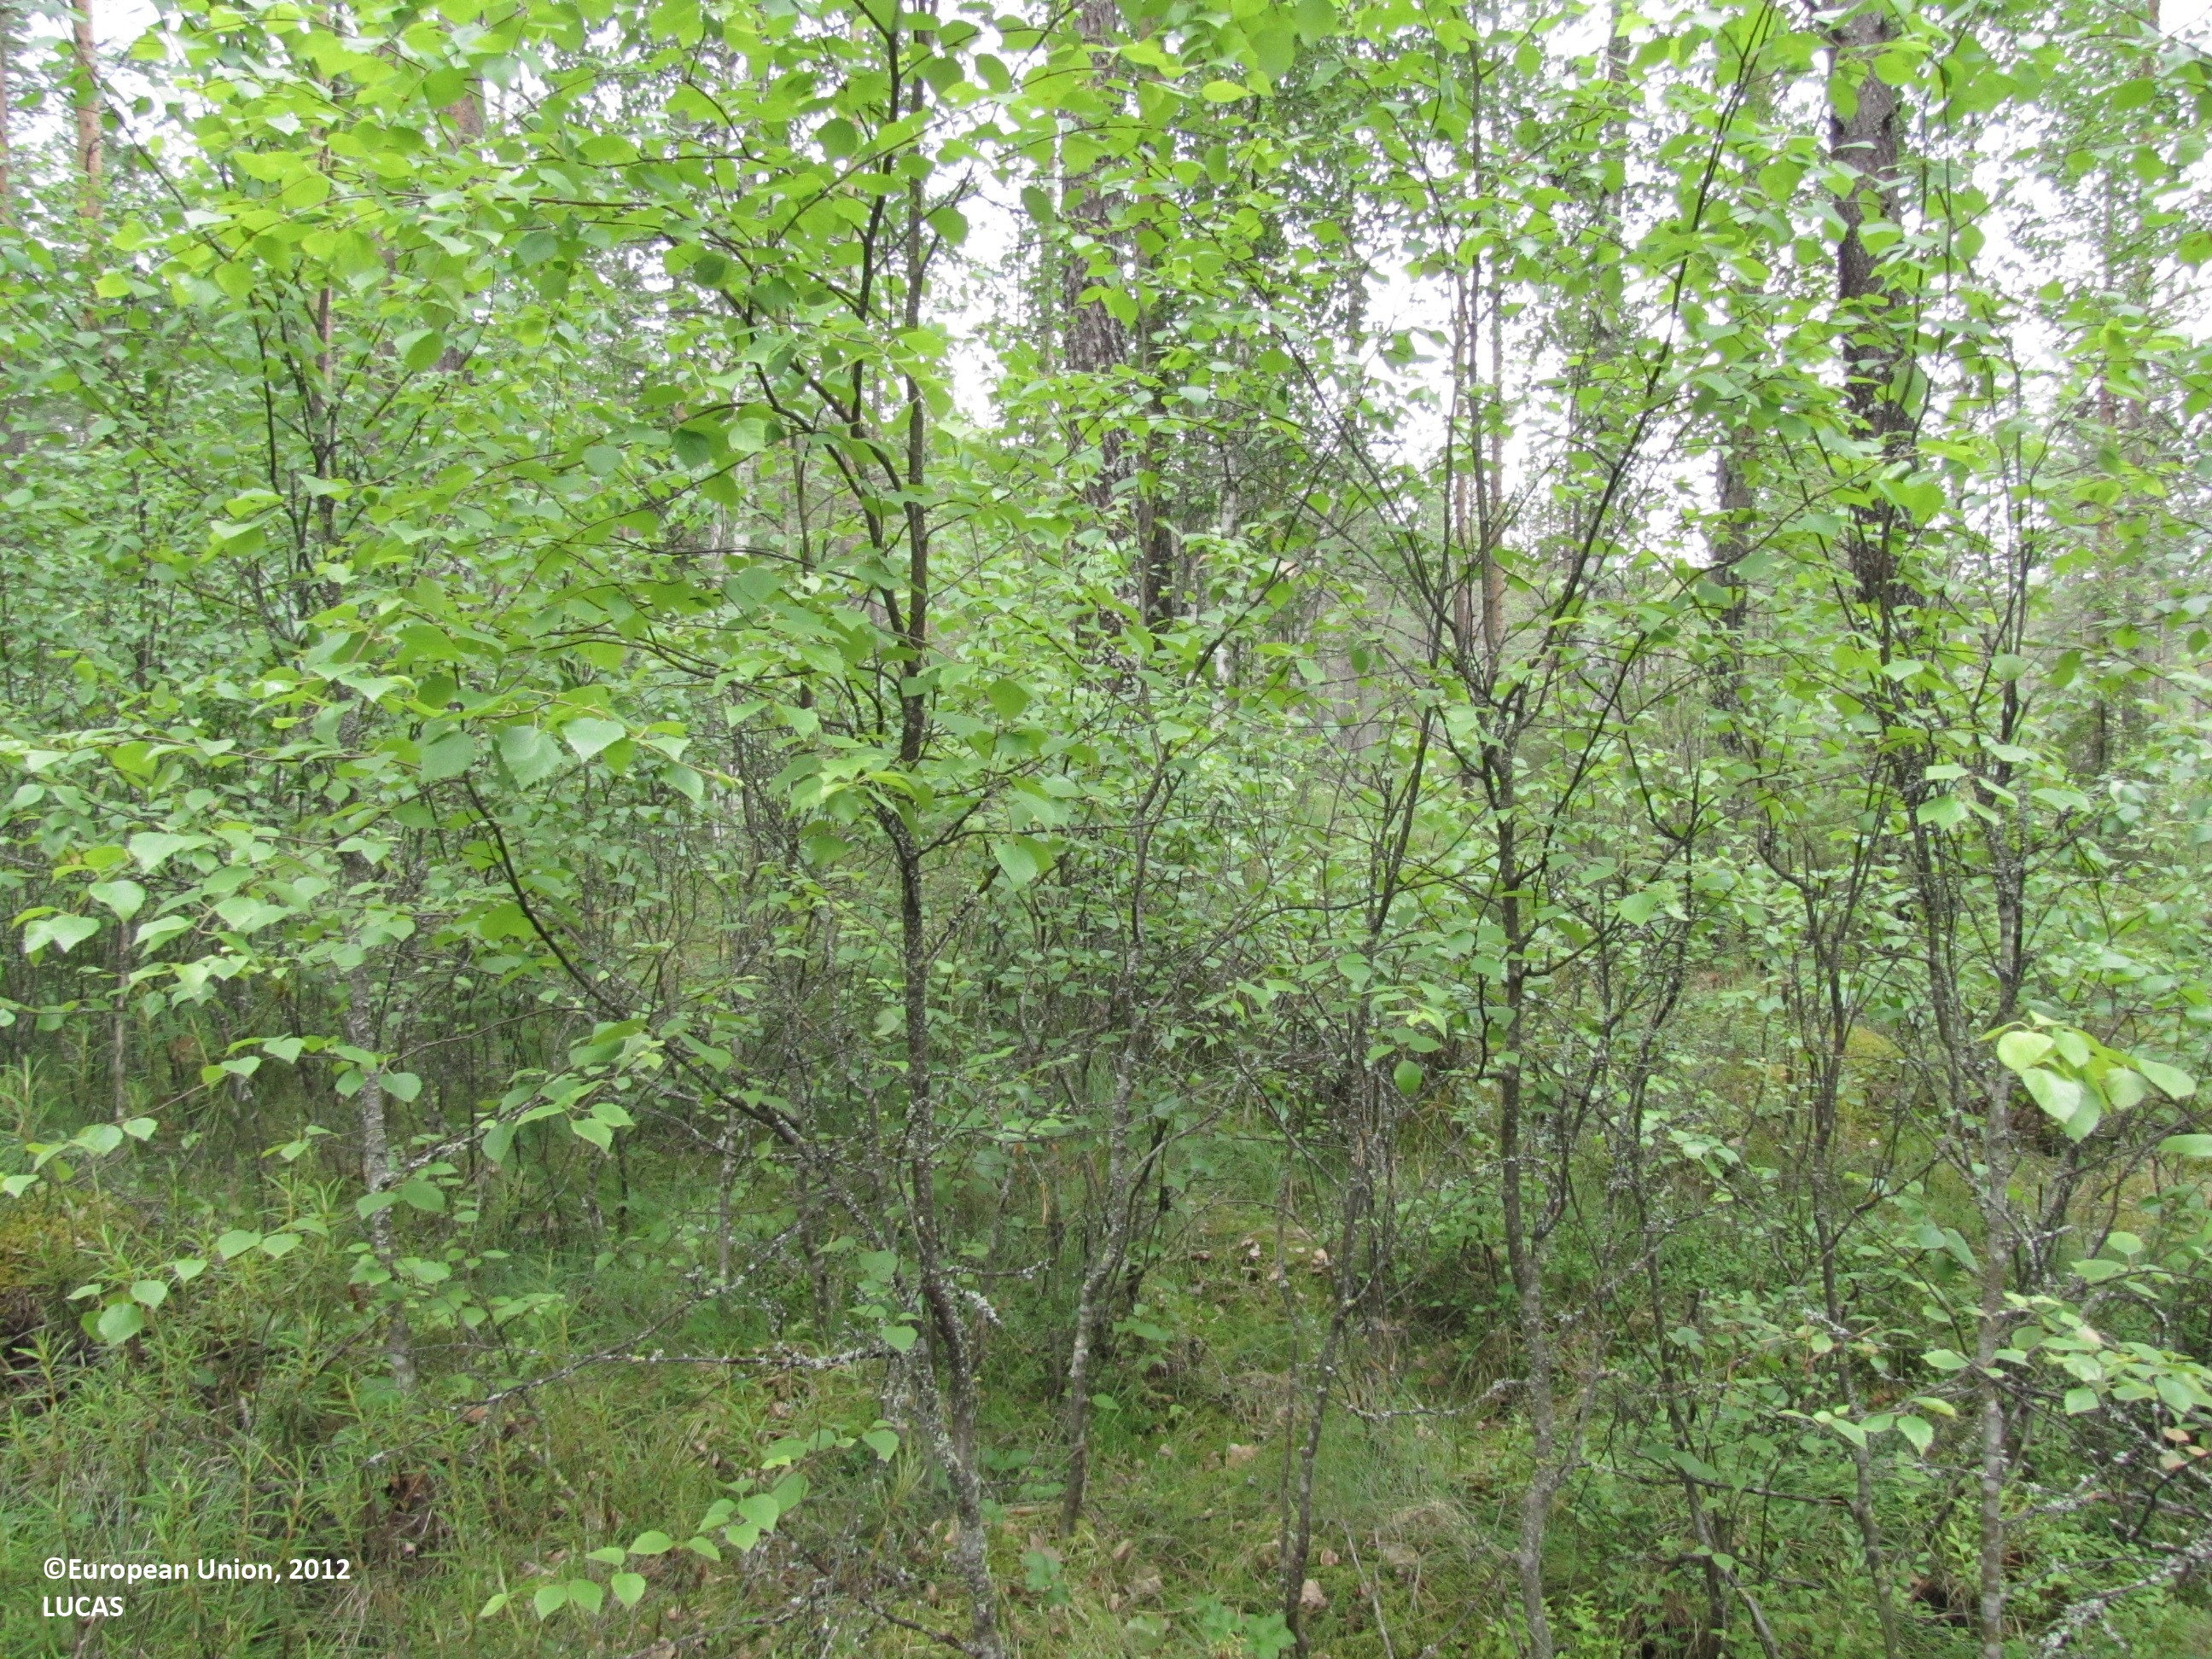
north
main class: Woodland
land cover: Pine dominated coniferous woodland
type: mire and swamp forests
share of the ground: > 75 %
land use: Community services
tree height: > 5 m
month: July
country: FI
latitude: 62.3464
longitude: 23.9277
